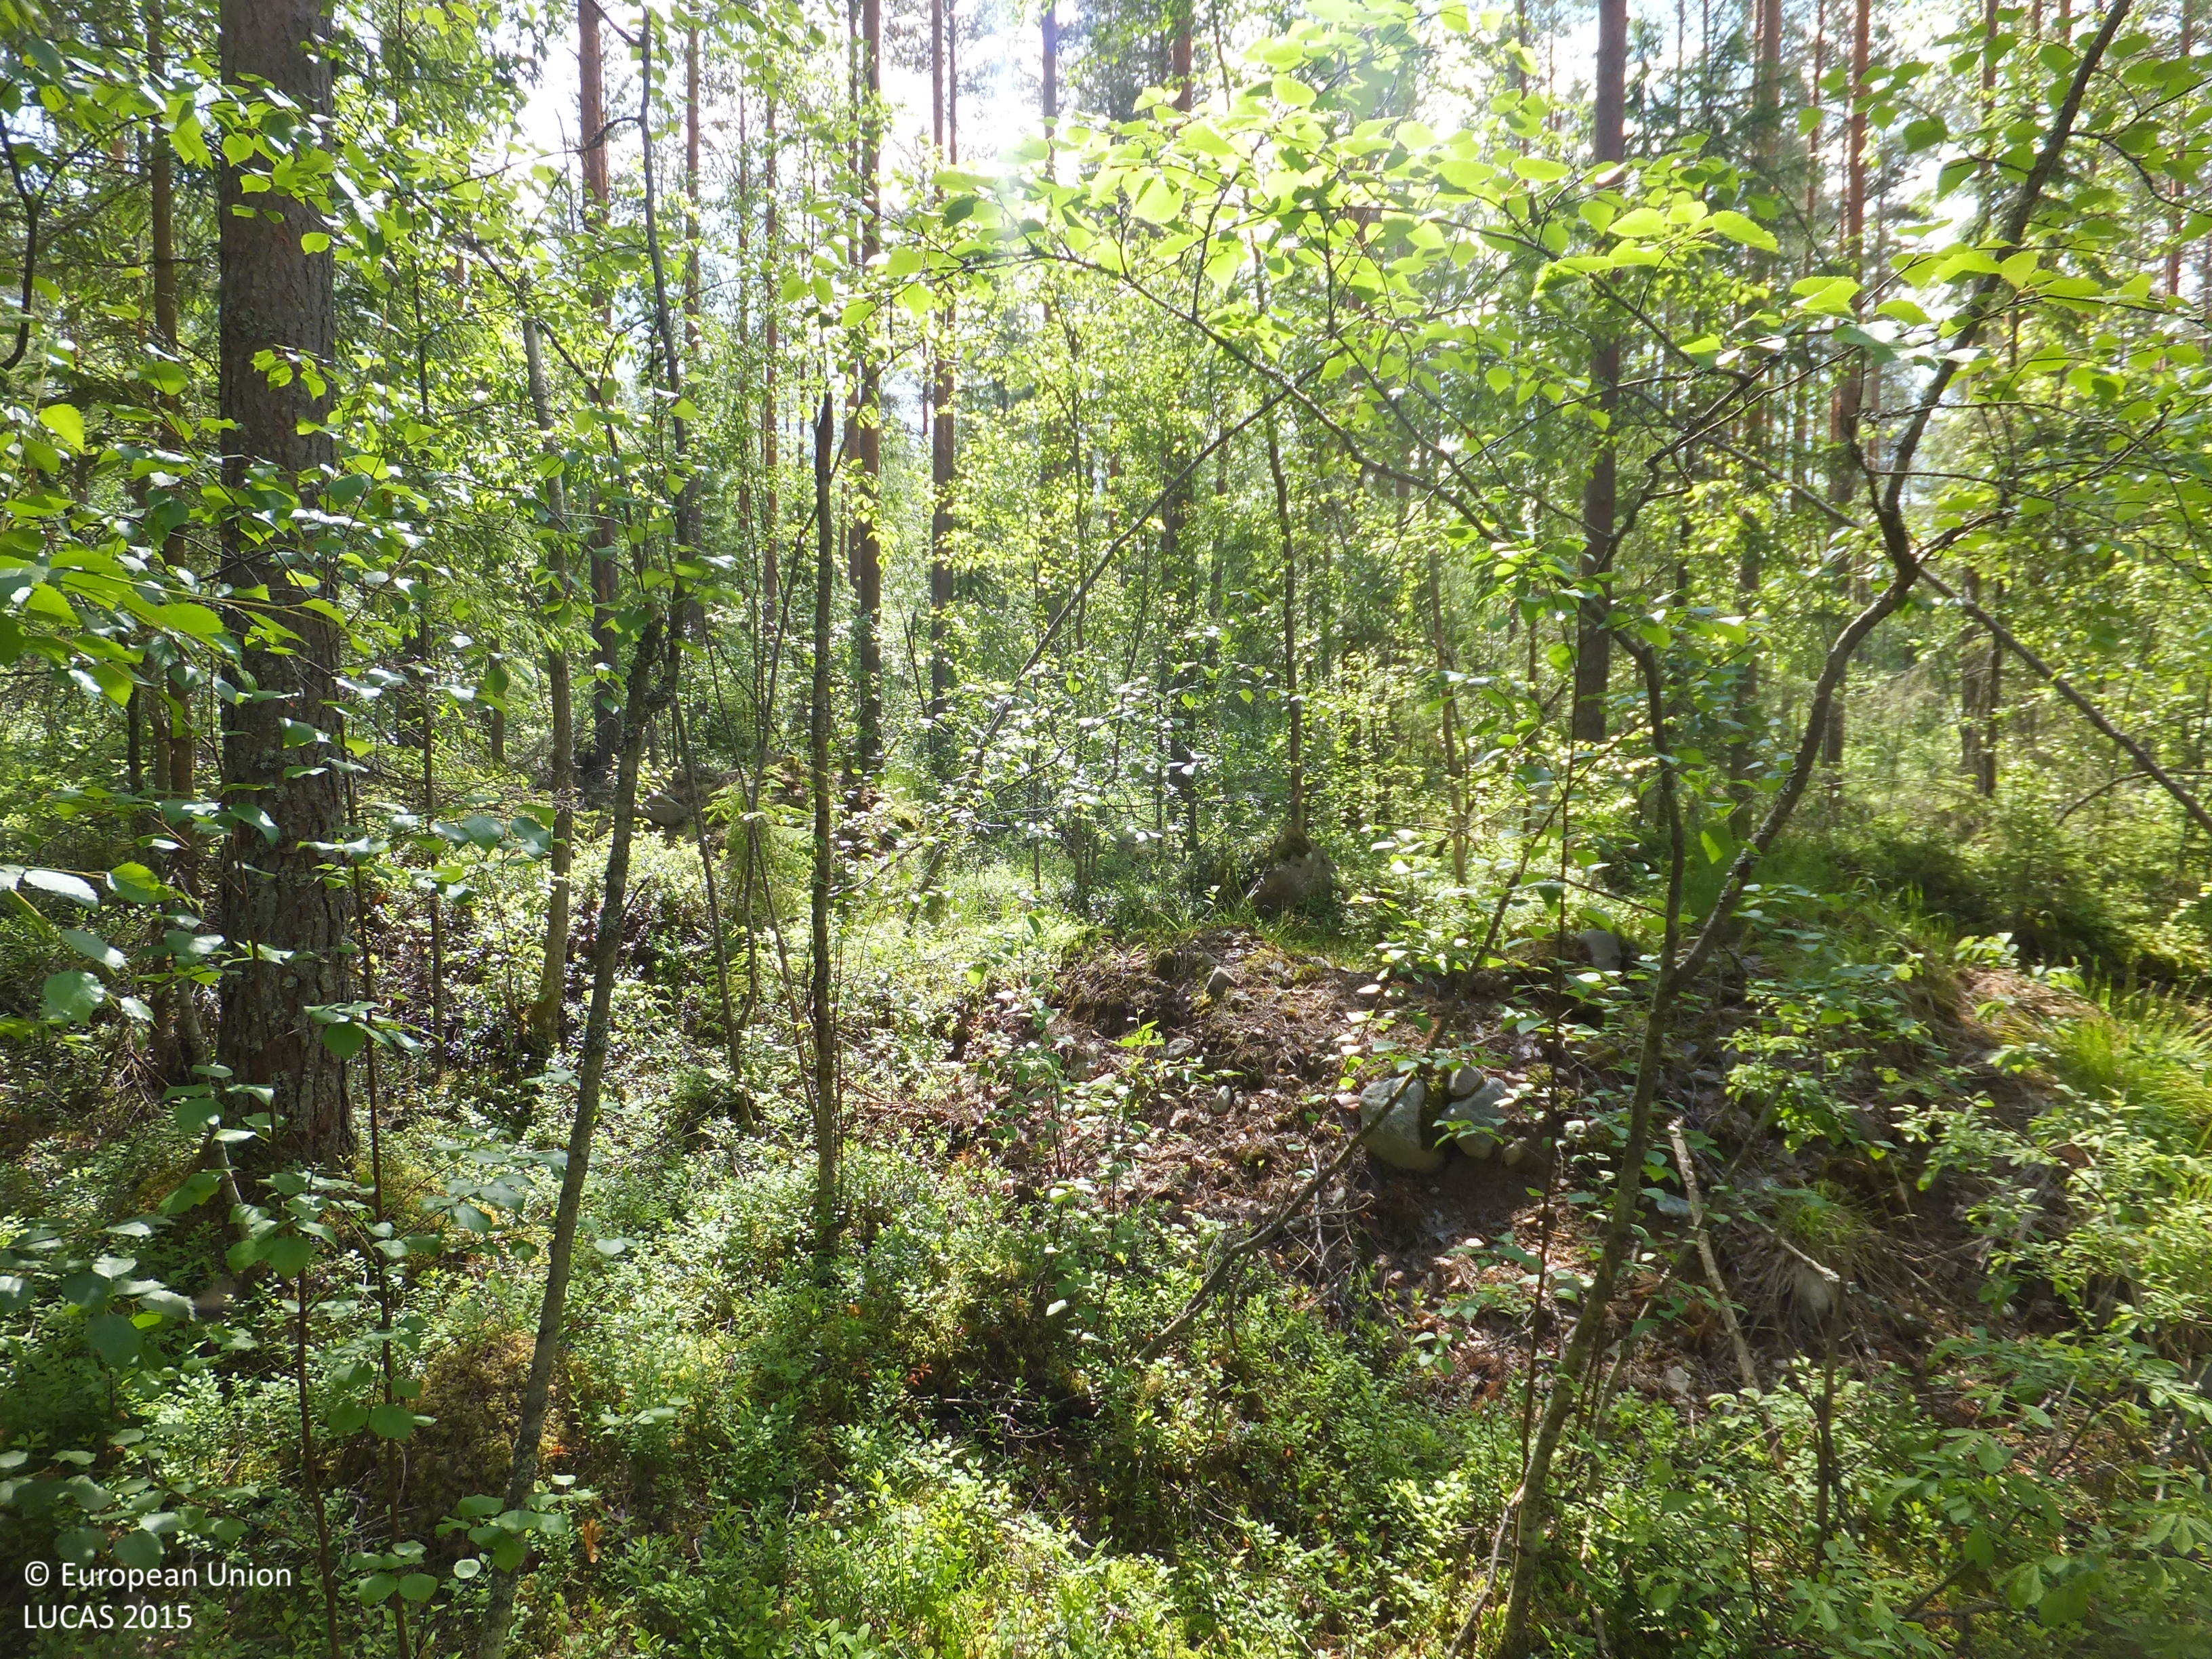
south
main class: Woodland
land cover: Pine dominated mixed woodland
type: boreal forest
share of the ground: 50 - 75 %
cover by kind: coniferous forest trees 35 %, broadleaved forest trees 25 %, shrubs 20 %, herbaceous plants 10 %, lichens and mosses 10 %
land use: Forestry
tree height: > 5 m
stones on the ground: 25 - 50 %
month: June
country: FI
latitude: 63.2024
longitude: 24.0105
